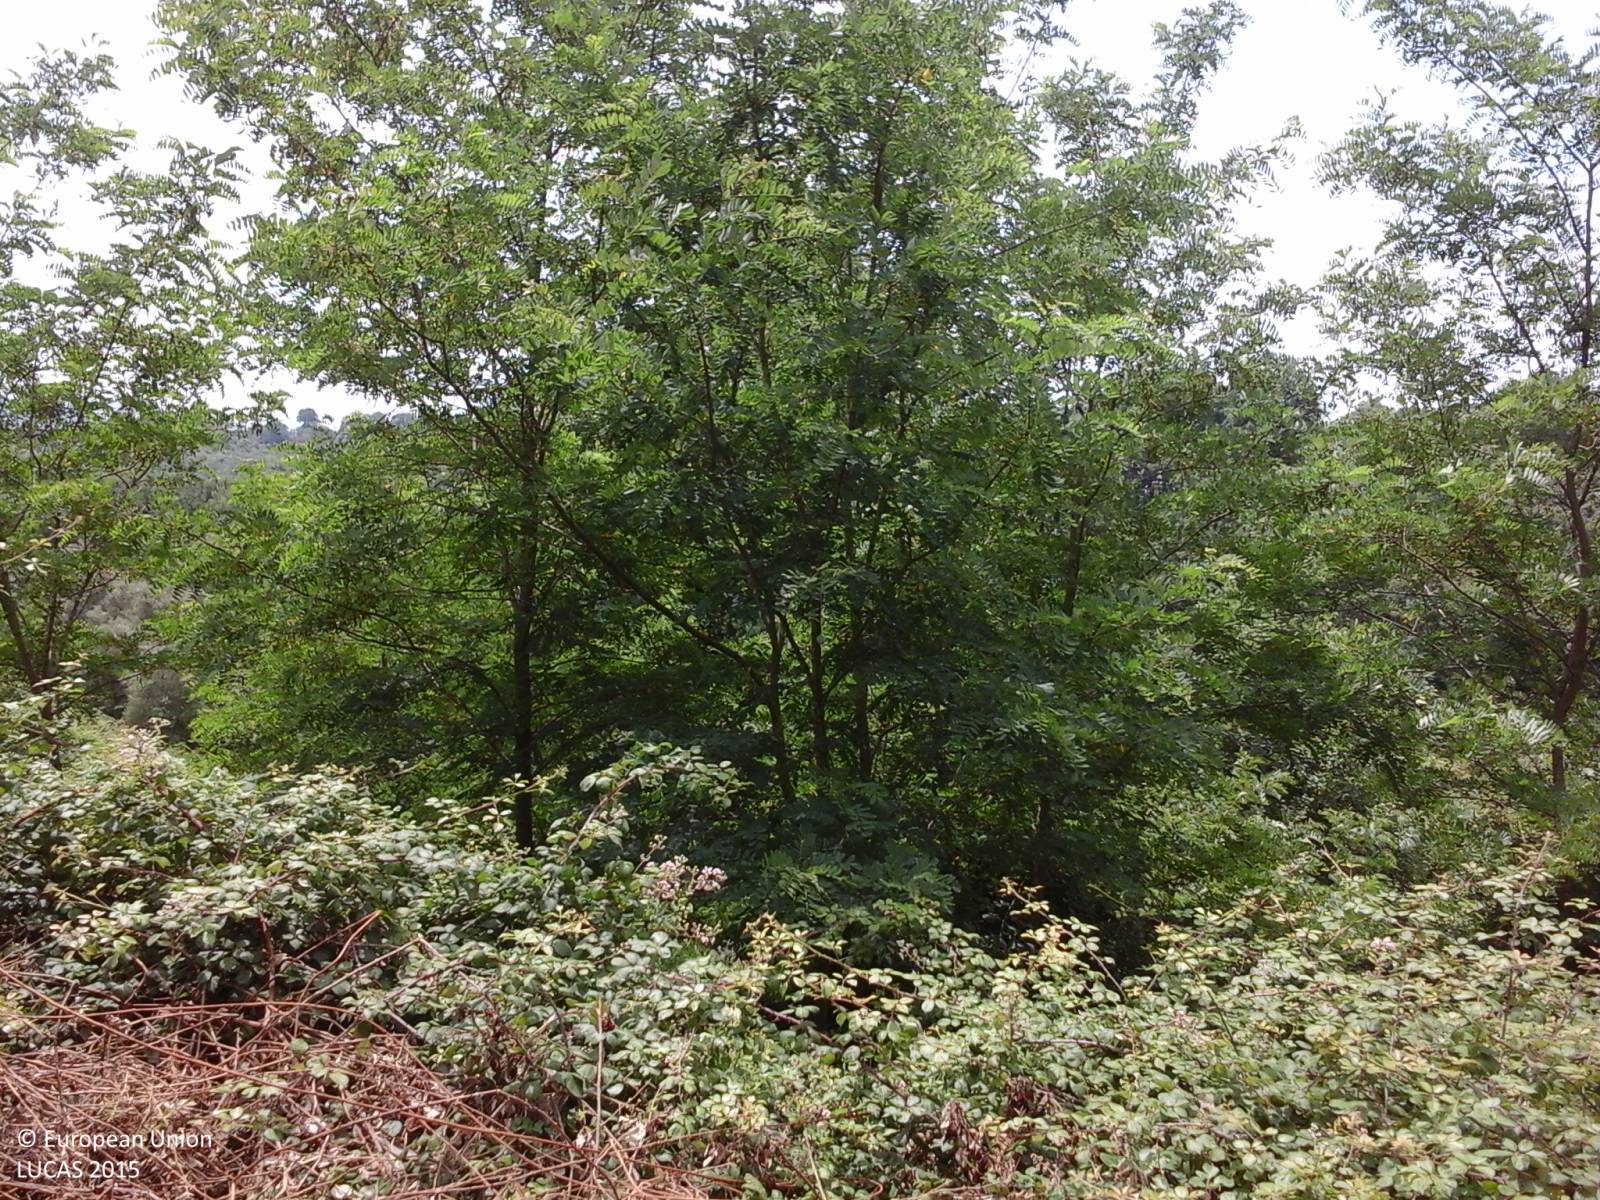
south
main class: Shrubland
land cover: Shrubland without tree cover
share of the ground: > 75 %
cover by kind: shrubs 95 %, unconsolidated bare surface 5 %
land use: Abandoned areas
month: June
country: IT
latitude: 41.2522
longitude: 14.0537
